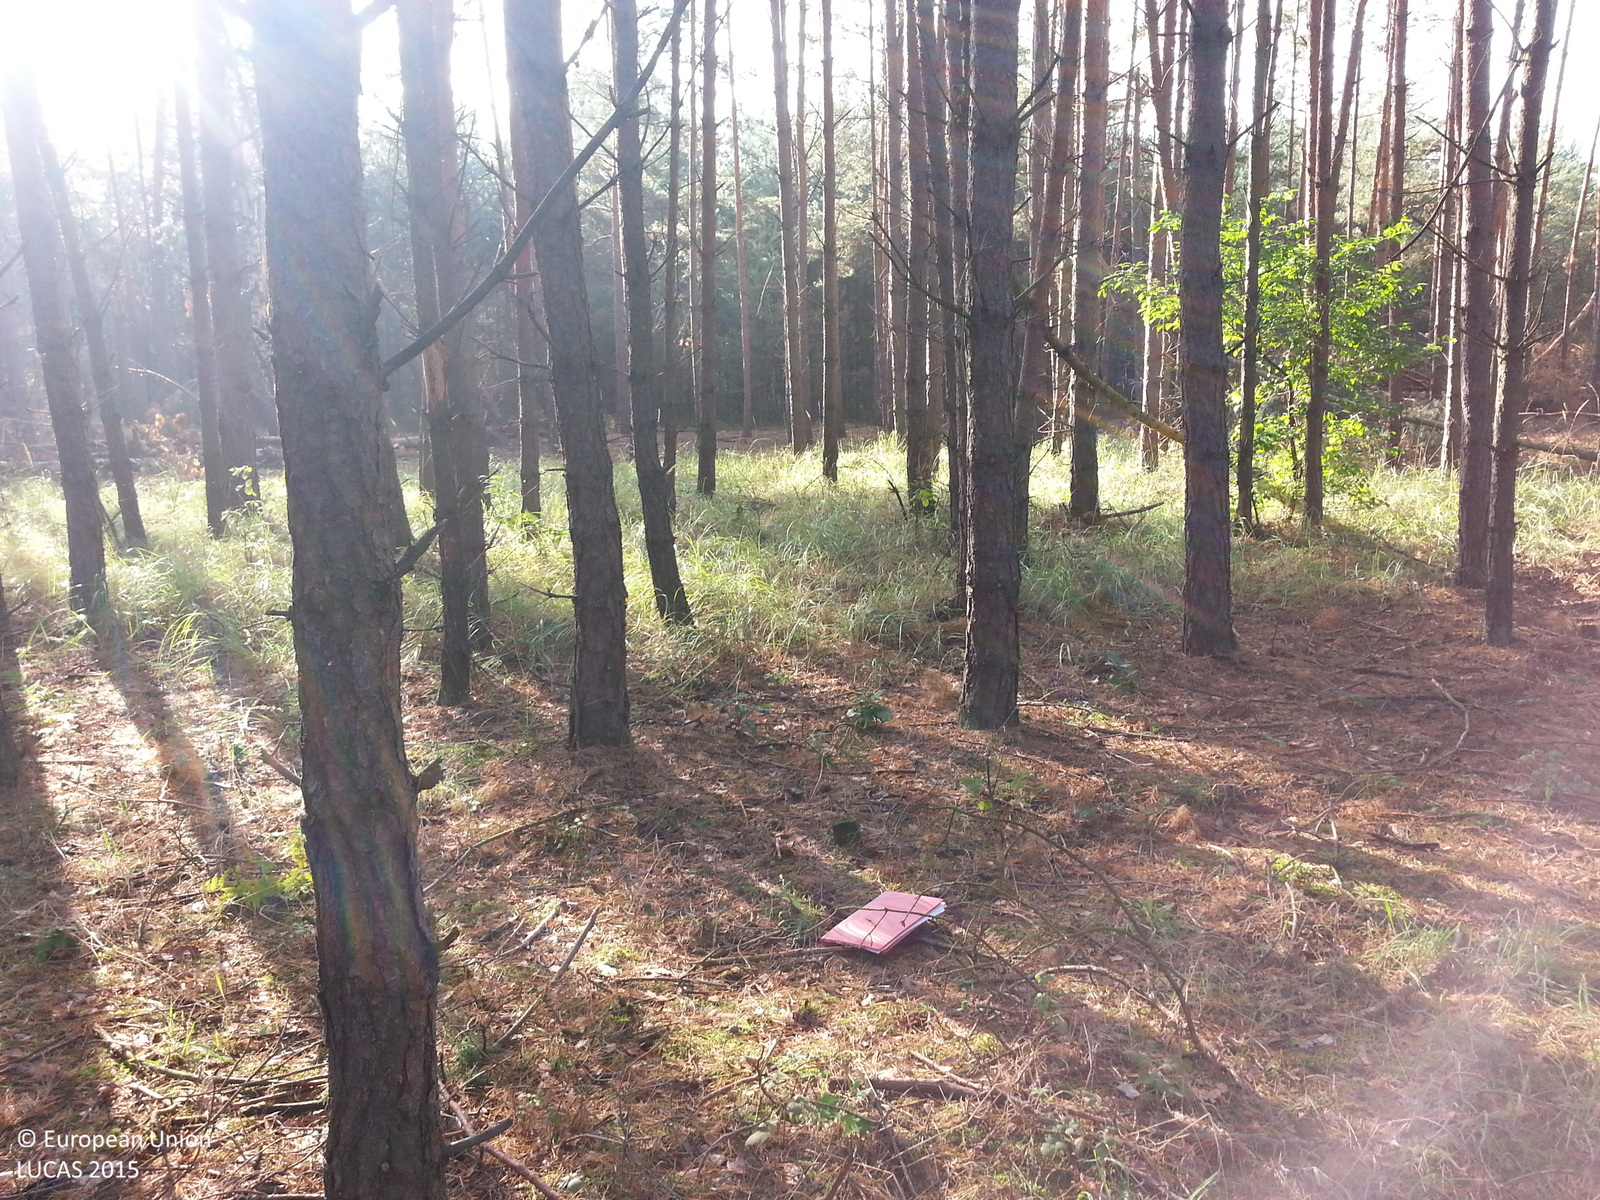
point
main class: Woodland
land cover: Pine dominated coniferous woodland
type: hemiboreal forest and nemoral coniferous forest and mixed broadleaved-coniferous forest
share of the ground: > 75 %
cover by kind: coniferous forest trees 70 %, broadleaved forest trees 10 %, herbaceous plants 10 %, lichens and mosses 5 %, unconsolidated bare surface 5 %
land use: Forestry
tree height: > 5 m
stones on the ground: < 10 %
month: September
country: PL
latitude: 53.1448
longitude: 19.1588
